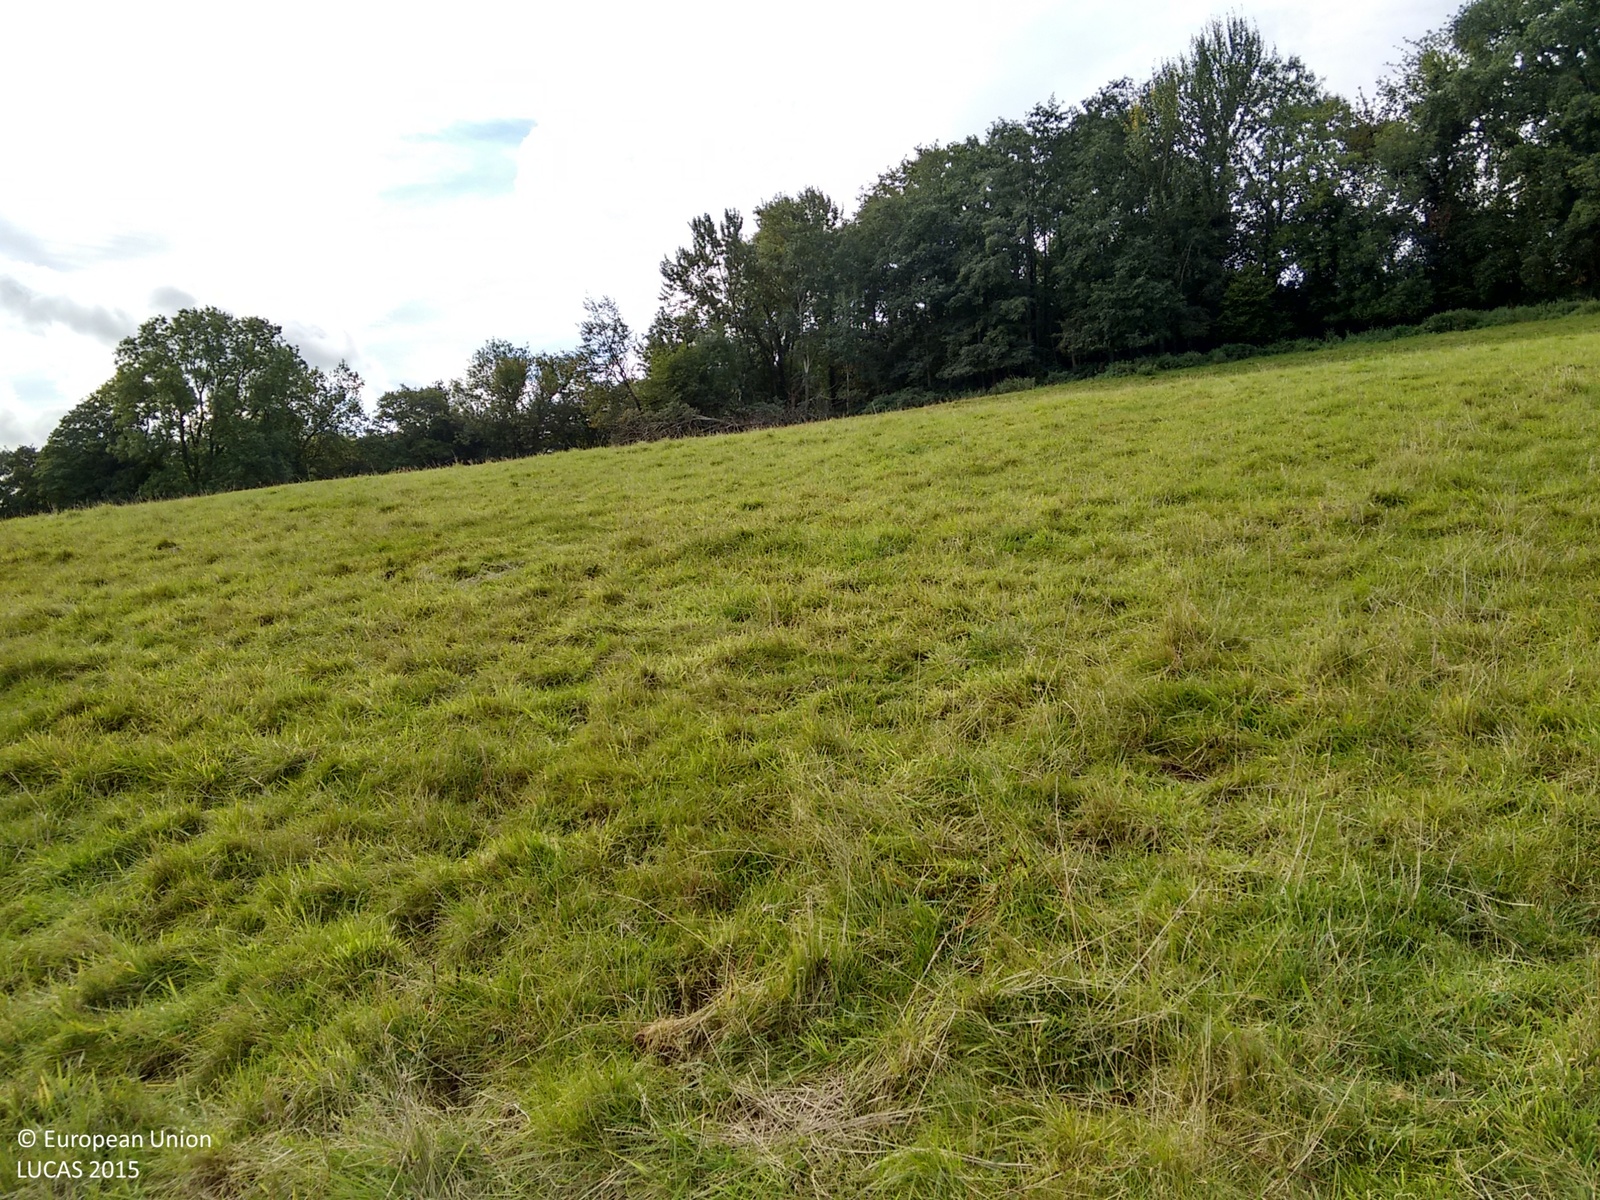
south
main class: Grassland
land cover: Grassland without tree/shrub cover
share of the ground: > 75 %
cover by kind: herbaceous plants 100 %
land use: Agriculture (excluding fallow land and kitchen gardens)
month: September
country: GB
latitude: 51.8016
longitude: -3.0256
